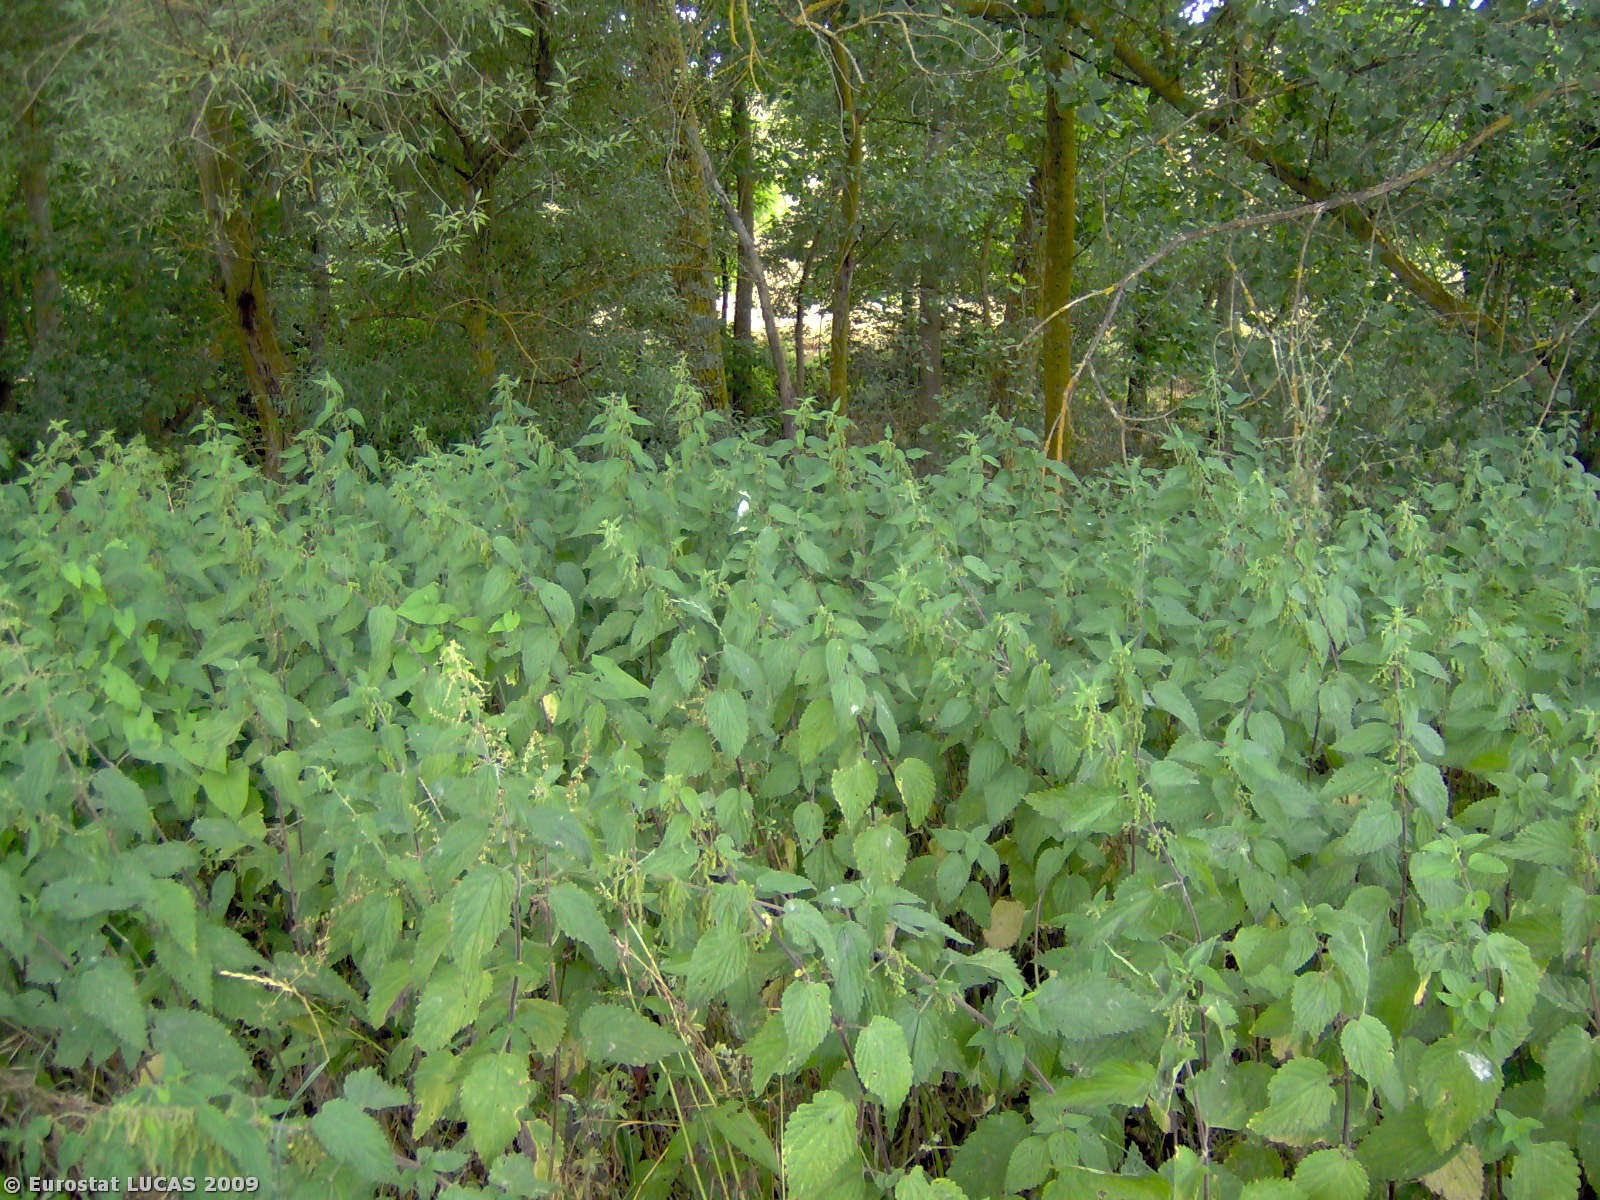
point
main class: Woodland
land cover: Broadleaved woodland
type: floodplain forest
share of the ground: > 75 %
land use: Unused
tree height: > 5 m
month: June
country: IT
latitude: 40.8848
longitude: 15.6401
